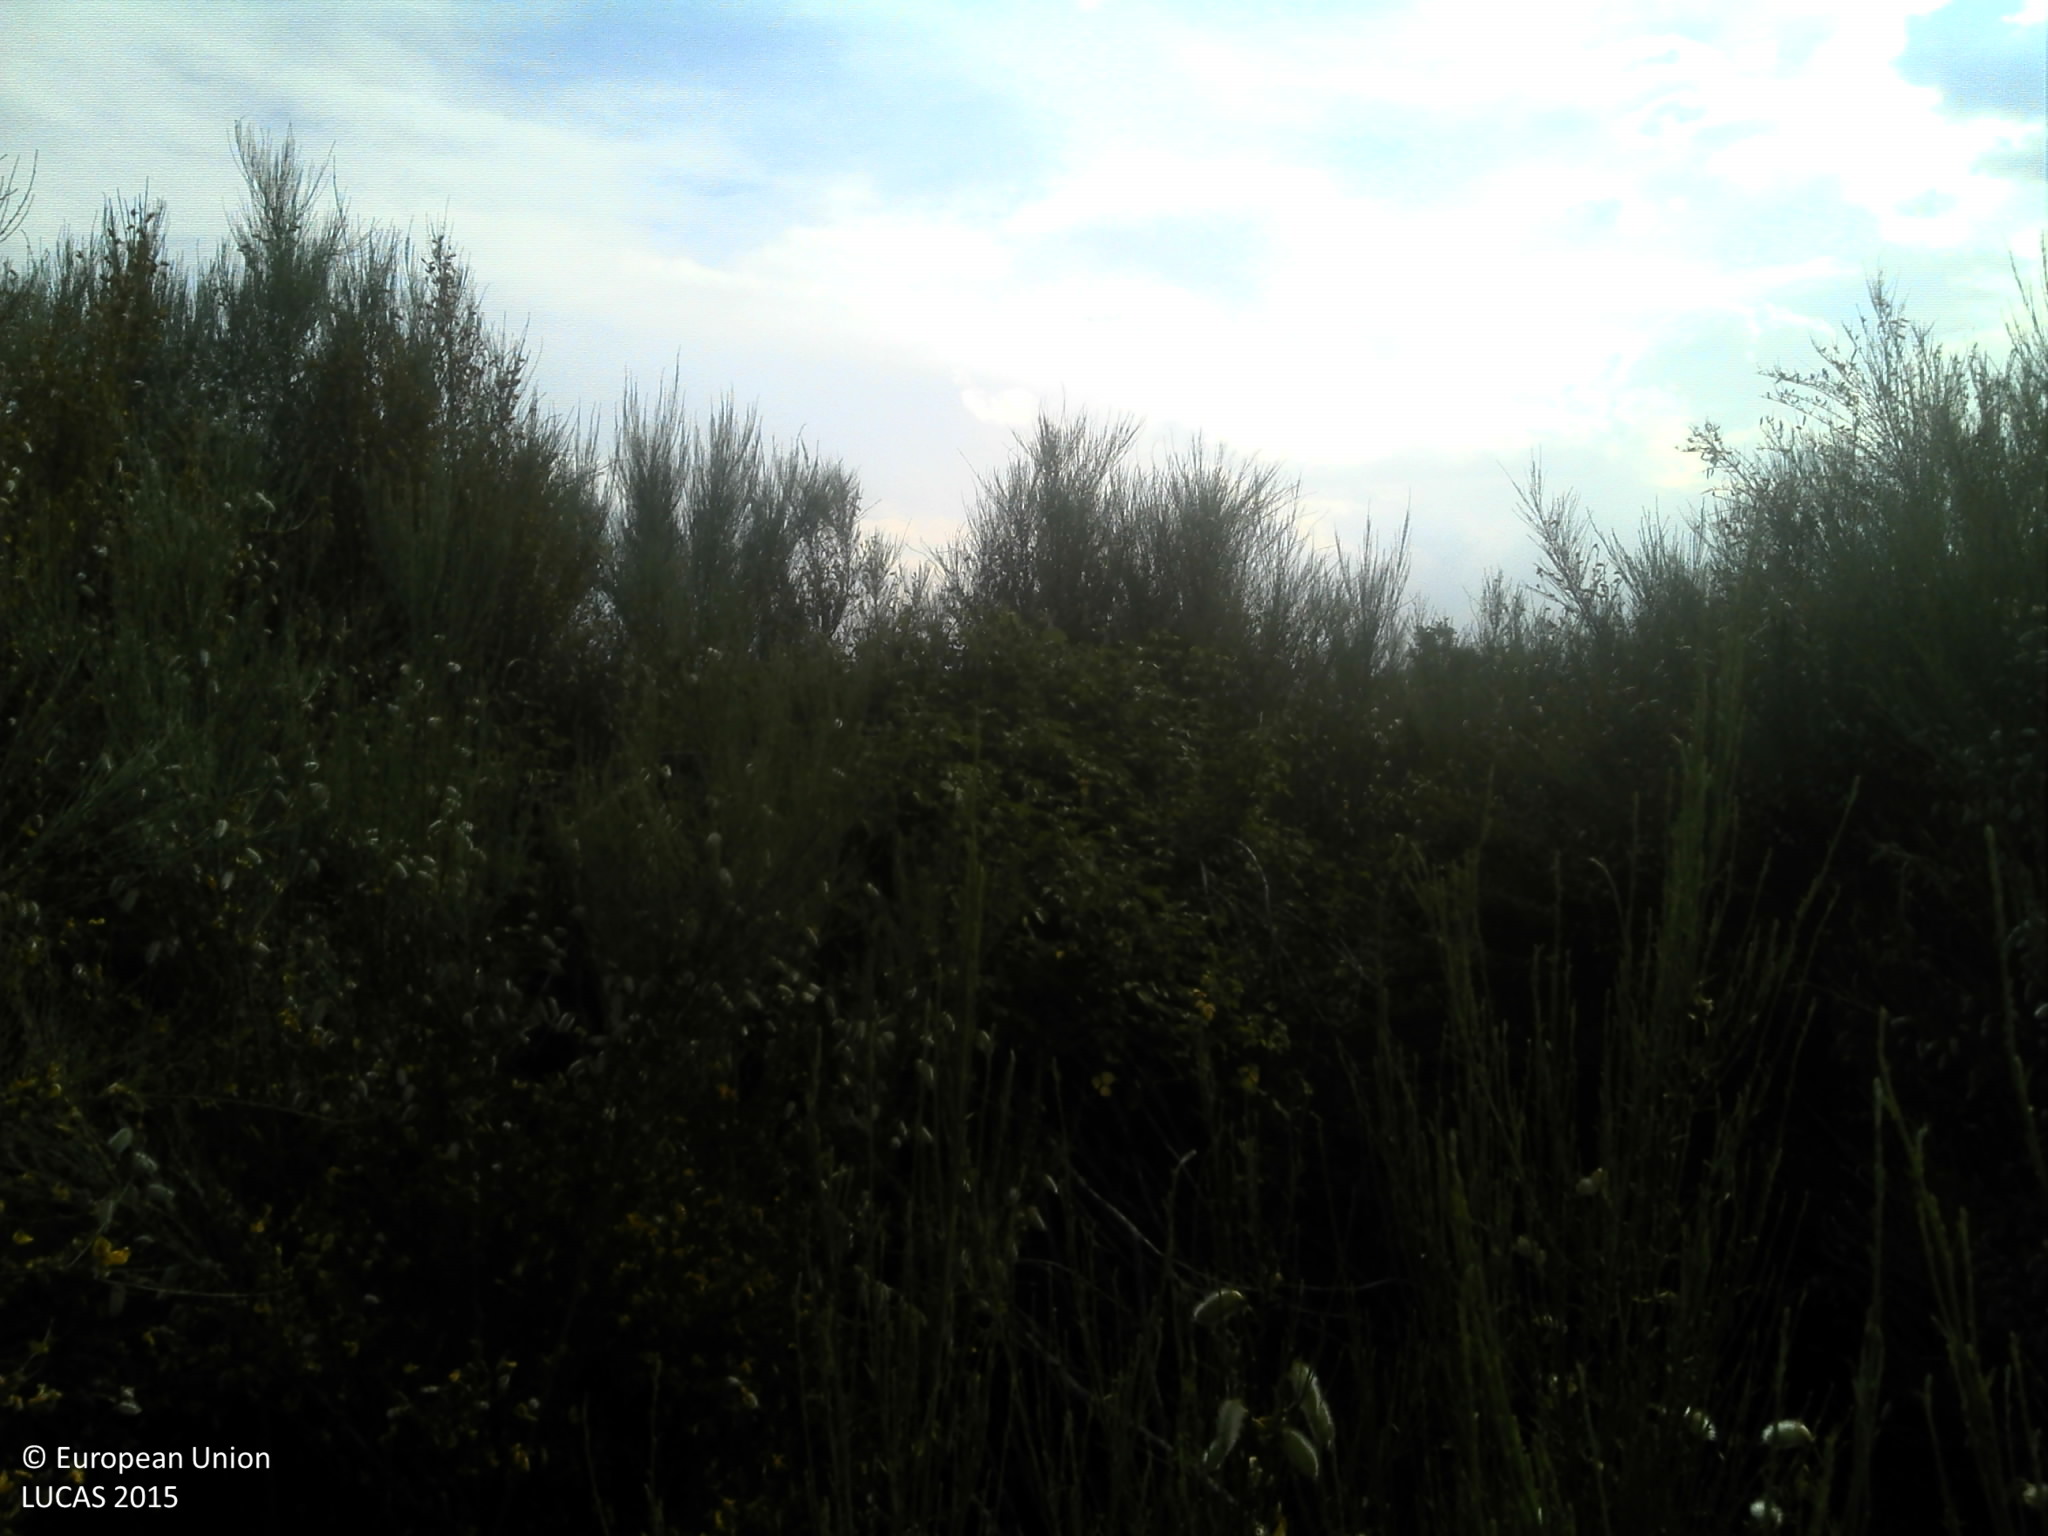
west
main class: Shrubland
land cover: Shrubland with sparse tree cover
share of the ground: 50 - 75 %
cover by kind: shrubs 75 %, unconsolidated bare surface 10 %, broadleaved forest trees 5 %, herbaceous plants 5 %
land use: Abandoned areas
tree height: < 5 m
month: June
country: PT
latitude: 40.3947
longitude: -7.1000
